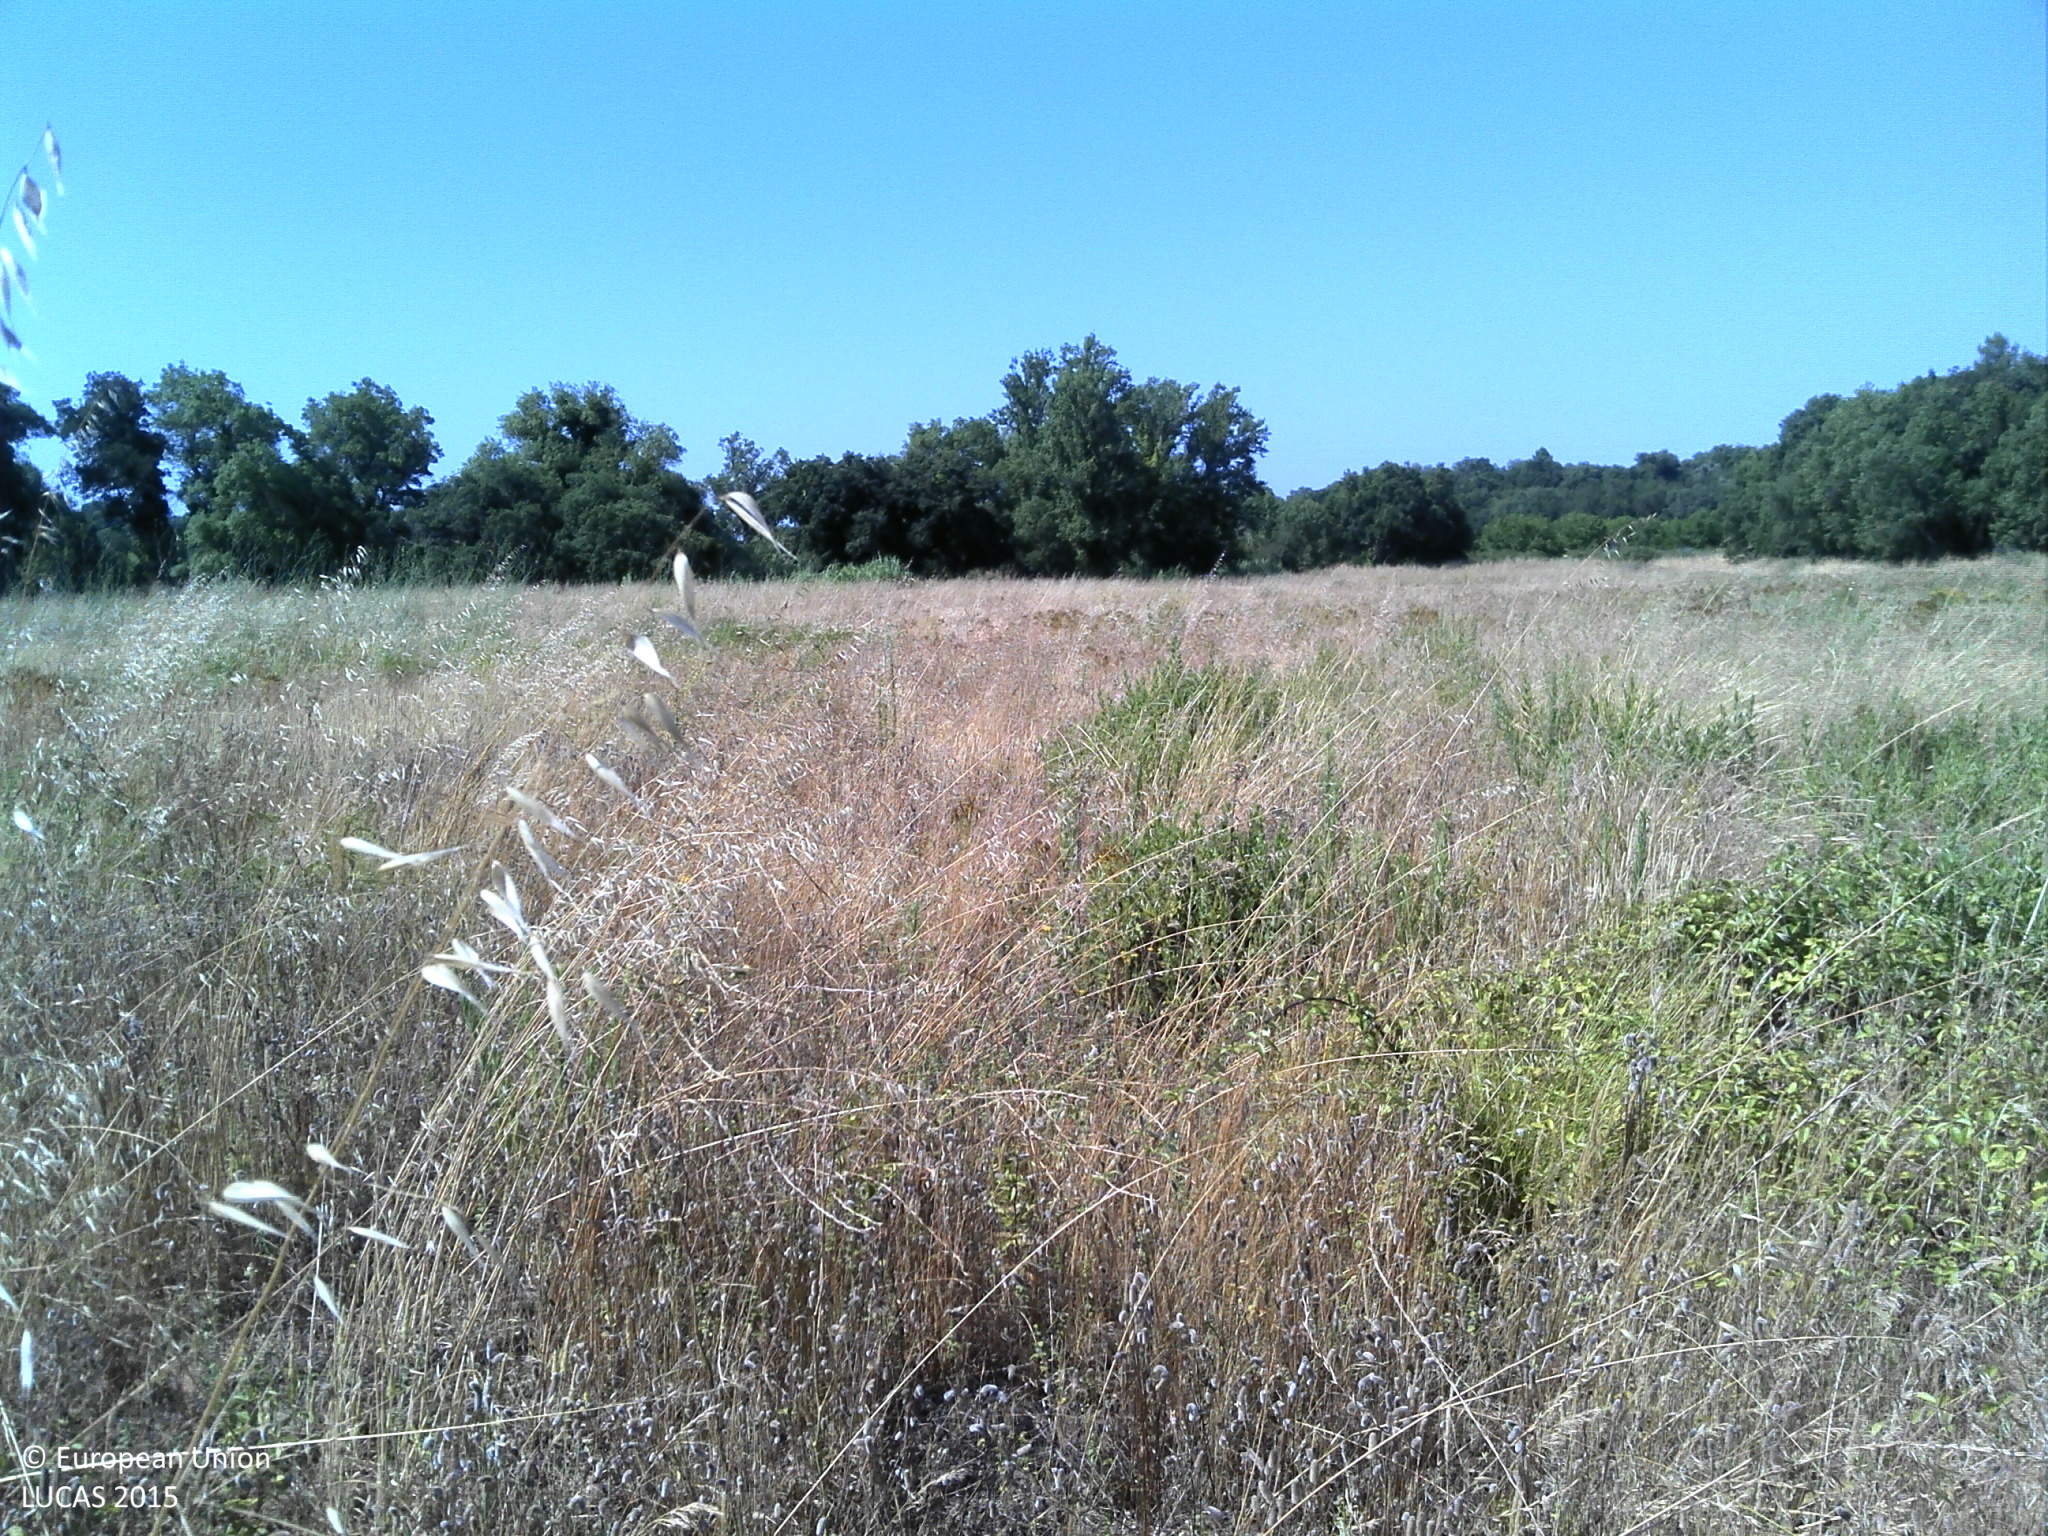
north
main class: Grassland
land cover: Spontaneously vegetated surfaces
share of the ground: 50 - 75 %
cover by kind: herbaceous plants 75 %, unconsolidated bare surface 25 %
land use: Fallow land
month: June
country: PT
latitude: 38.5112
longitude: -9.0481
